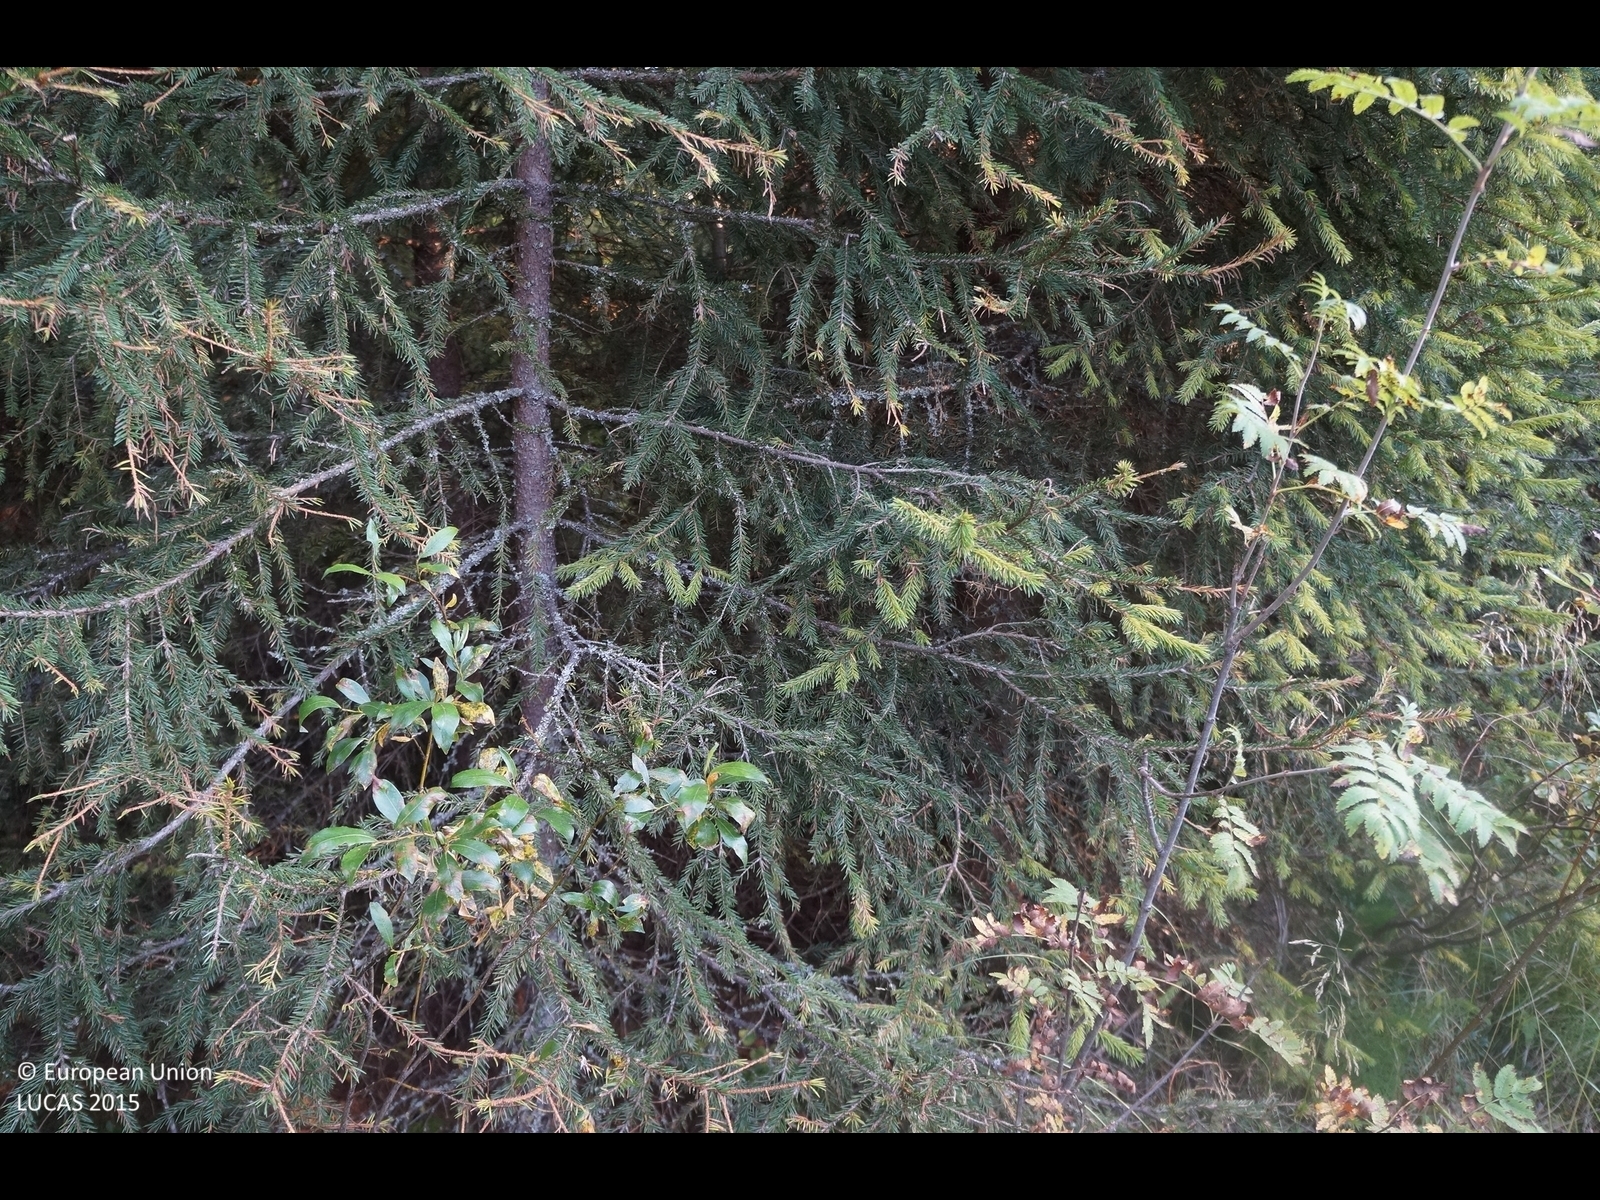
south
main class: Woodland
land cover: Spruce dominated mixed woodland
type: boreal forest
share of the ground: 50 - 75 %
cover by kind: coniferous forest trees 45 %, shrubs 25 %, broadleaved forest trees 20 %, herbaceous plants 5 %, lichens and mosses 5 %
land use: Forestry
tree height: > 5 m
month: August
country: FI
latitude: 64.1563
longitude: 25.0313
